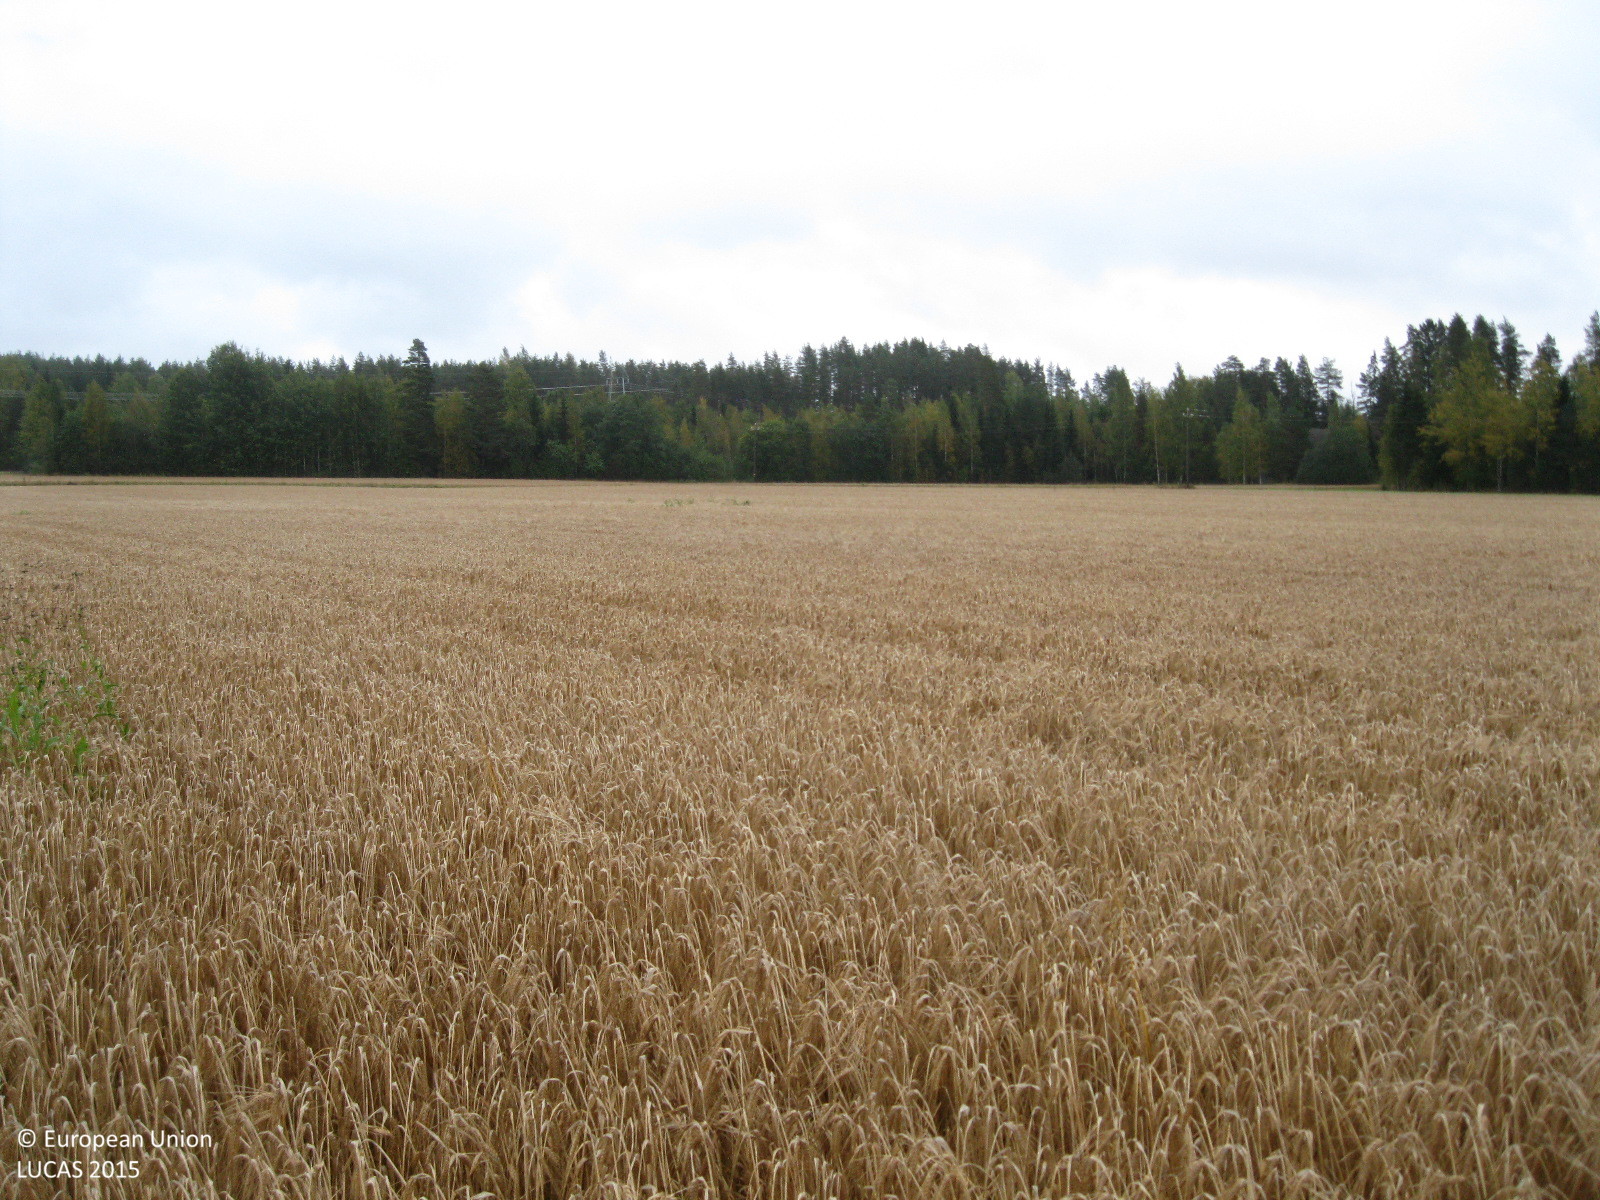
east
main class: Cropland
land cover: Barley
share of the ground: > 75 %
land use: Agriculture (excluding fallow land and kitchen gardens)
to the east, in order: Barley; Grass margins; Paved roads, cycling and walking lanes; Grass margins; Barley
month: September
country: FI
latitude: 60.8299
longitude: 24.7686
